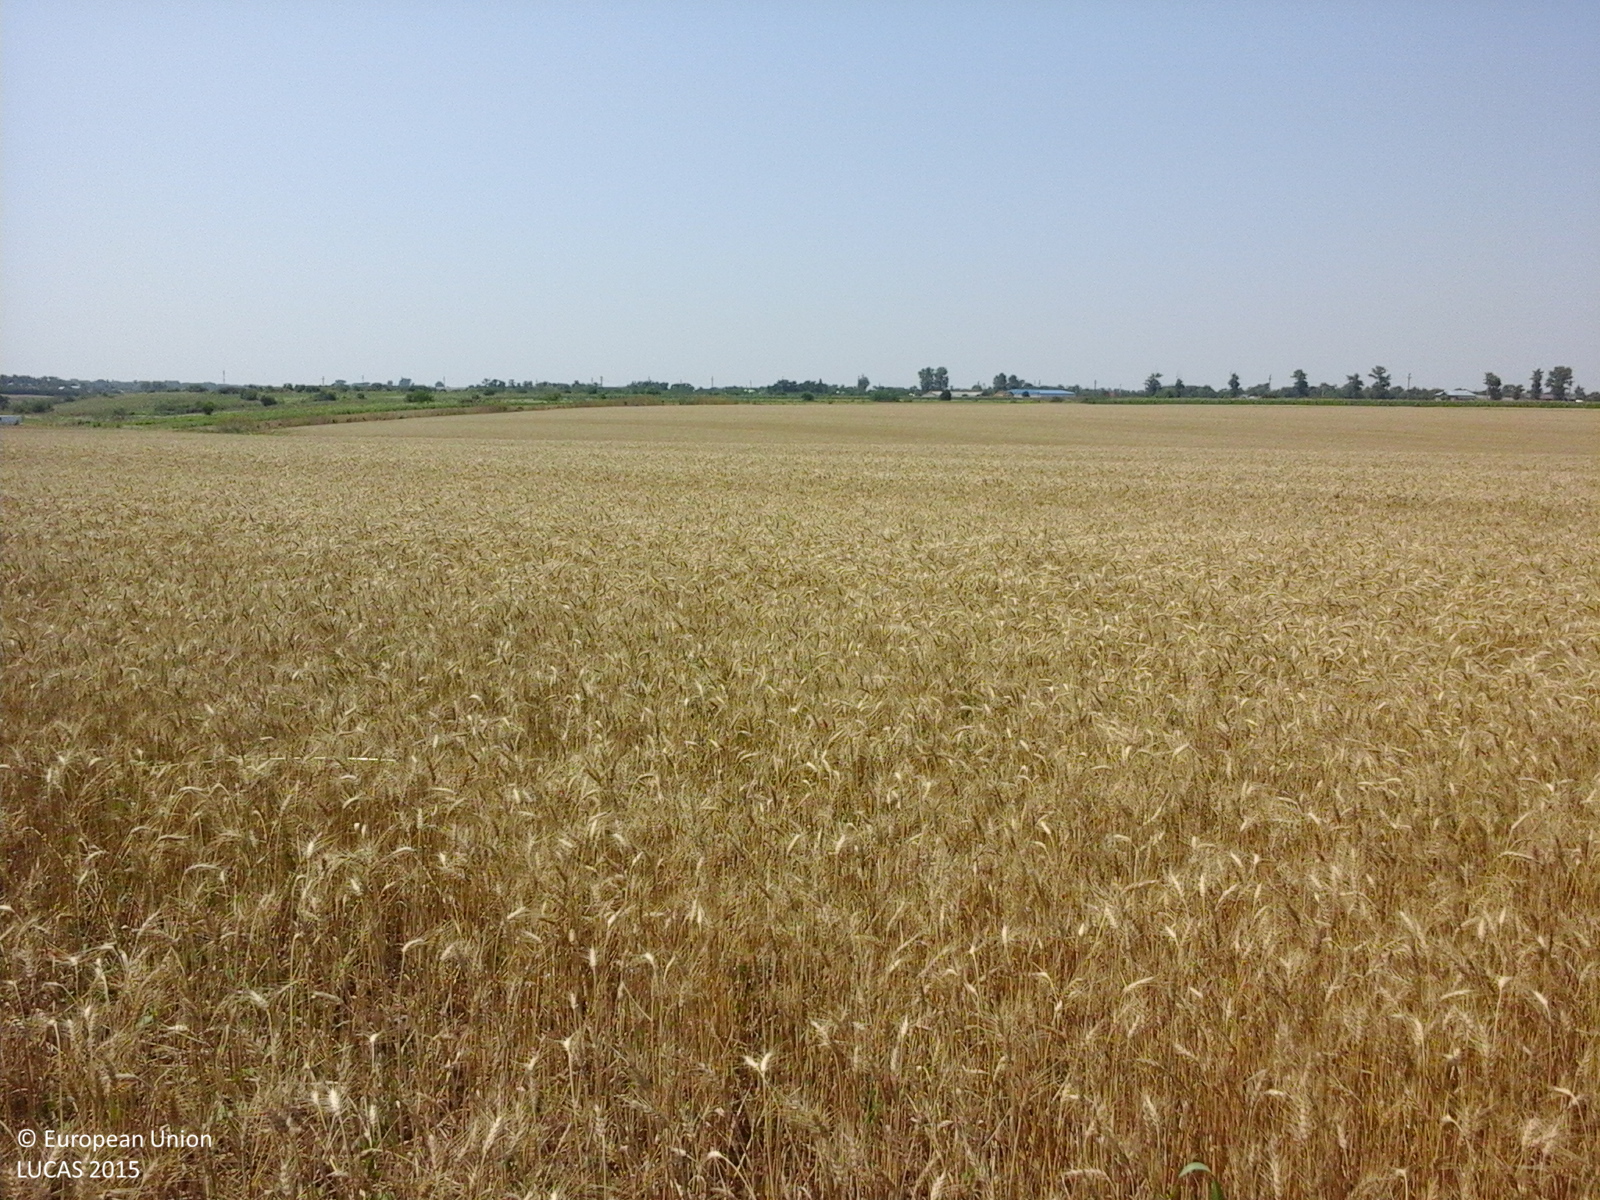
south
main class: Cropland
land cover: Common wheat
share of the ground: > 75 %
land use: Agriculture (excluding fallow land and kitchen gardens)
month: July
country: RO
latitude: 44.2026
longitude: 25.3905
